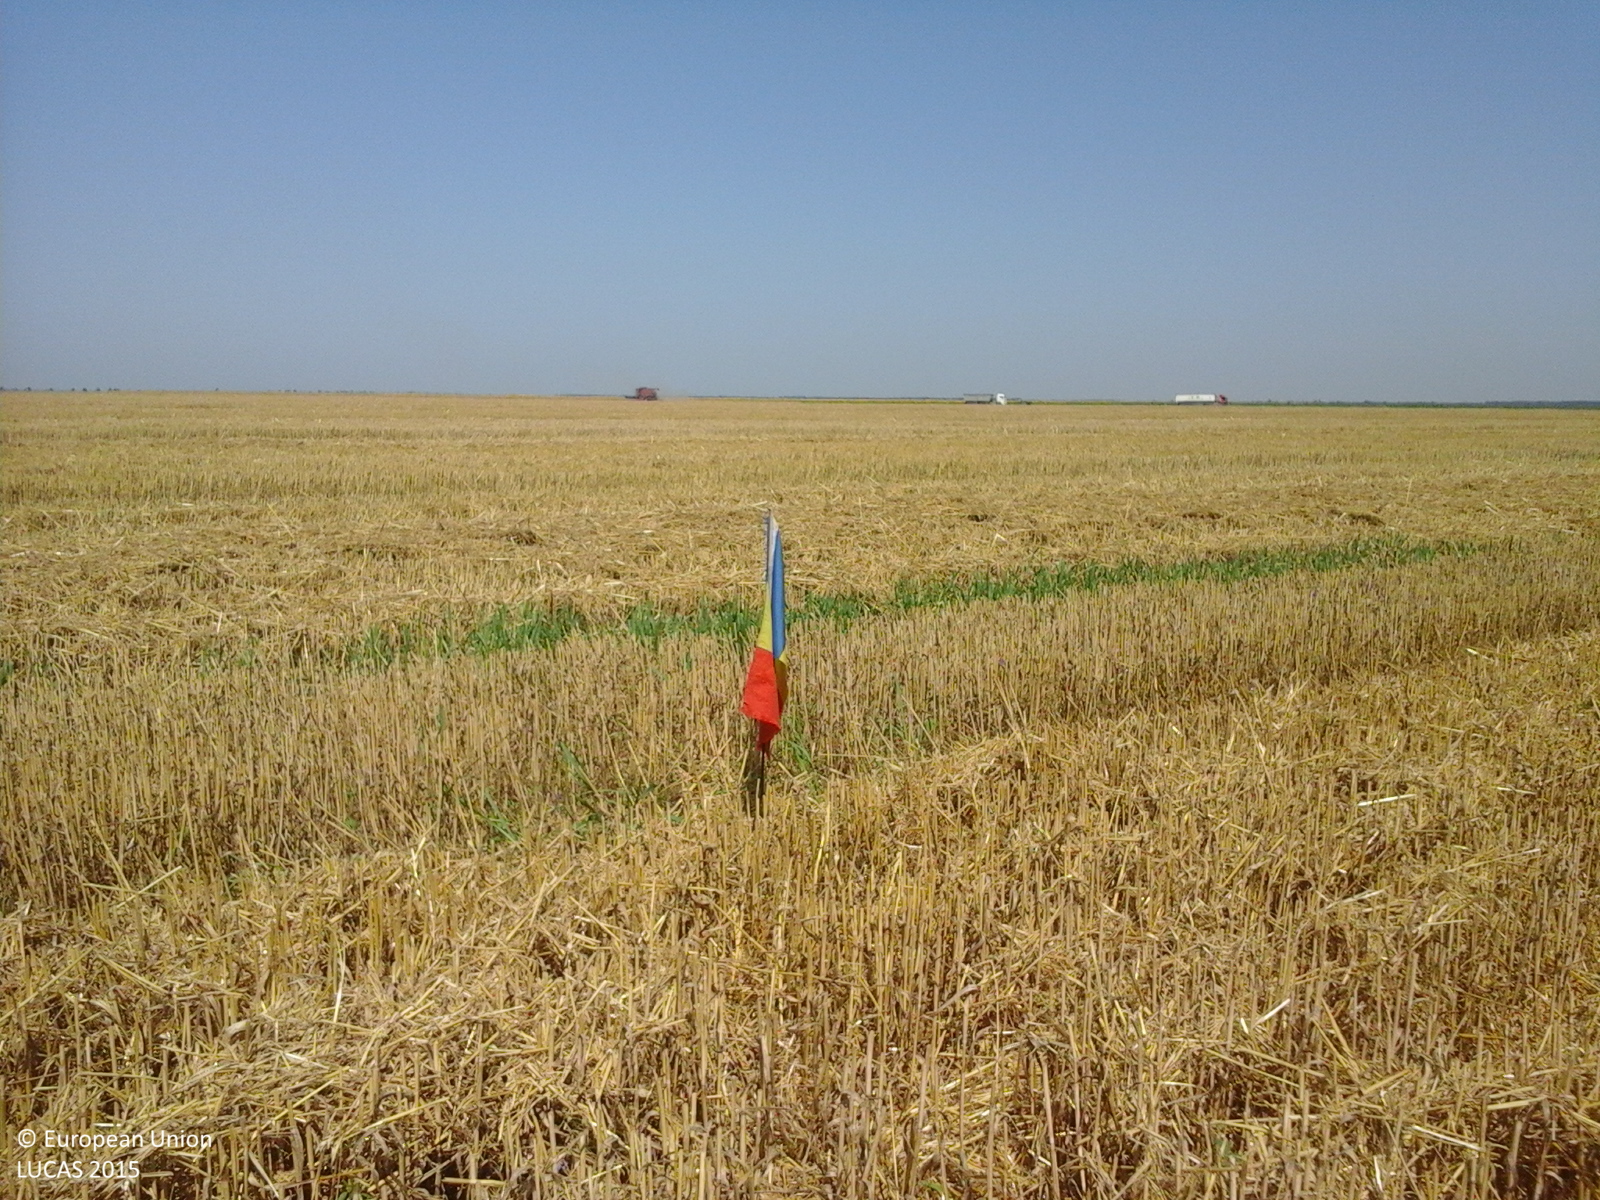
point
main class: Cropland
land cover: Common wheat
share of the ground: < 10 %
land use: Agriculture (excluding fallow land and kitchen gardens)
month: July
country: RO
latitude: 44.1307
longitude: 24.6308
